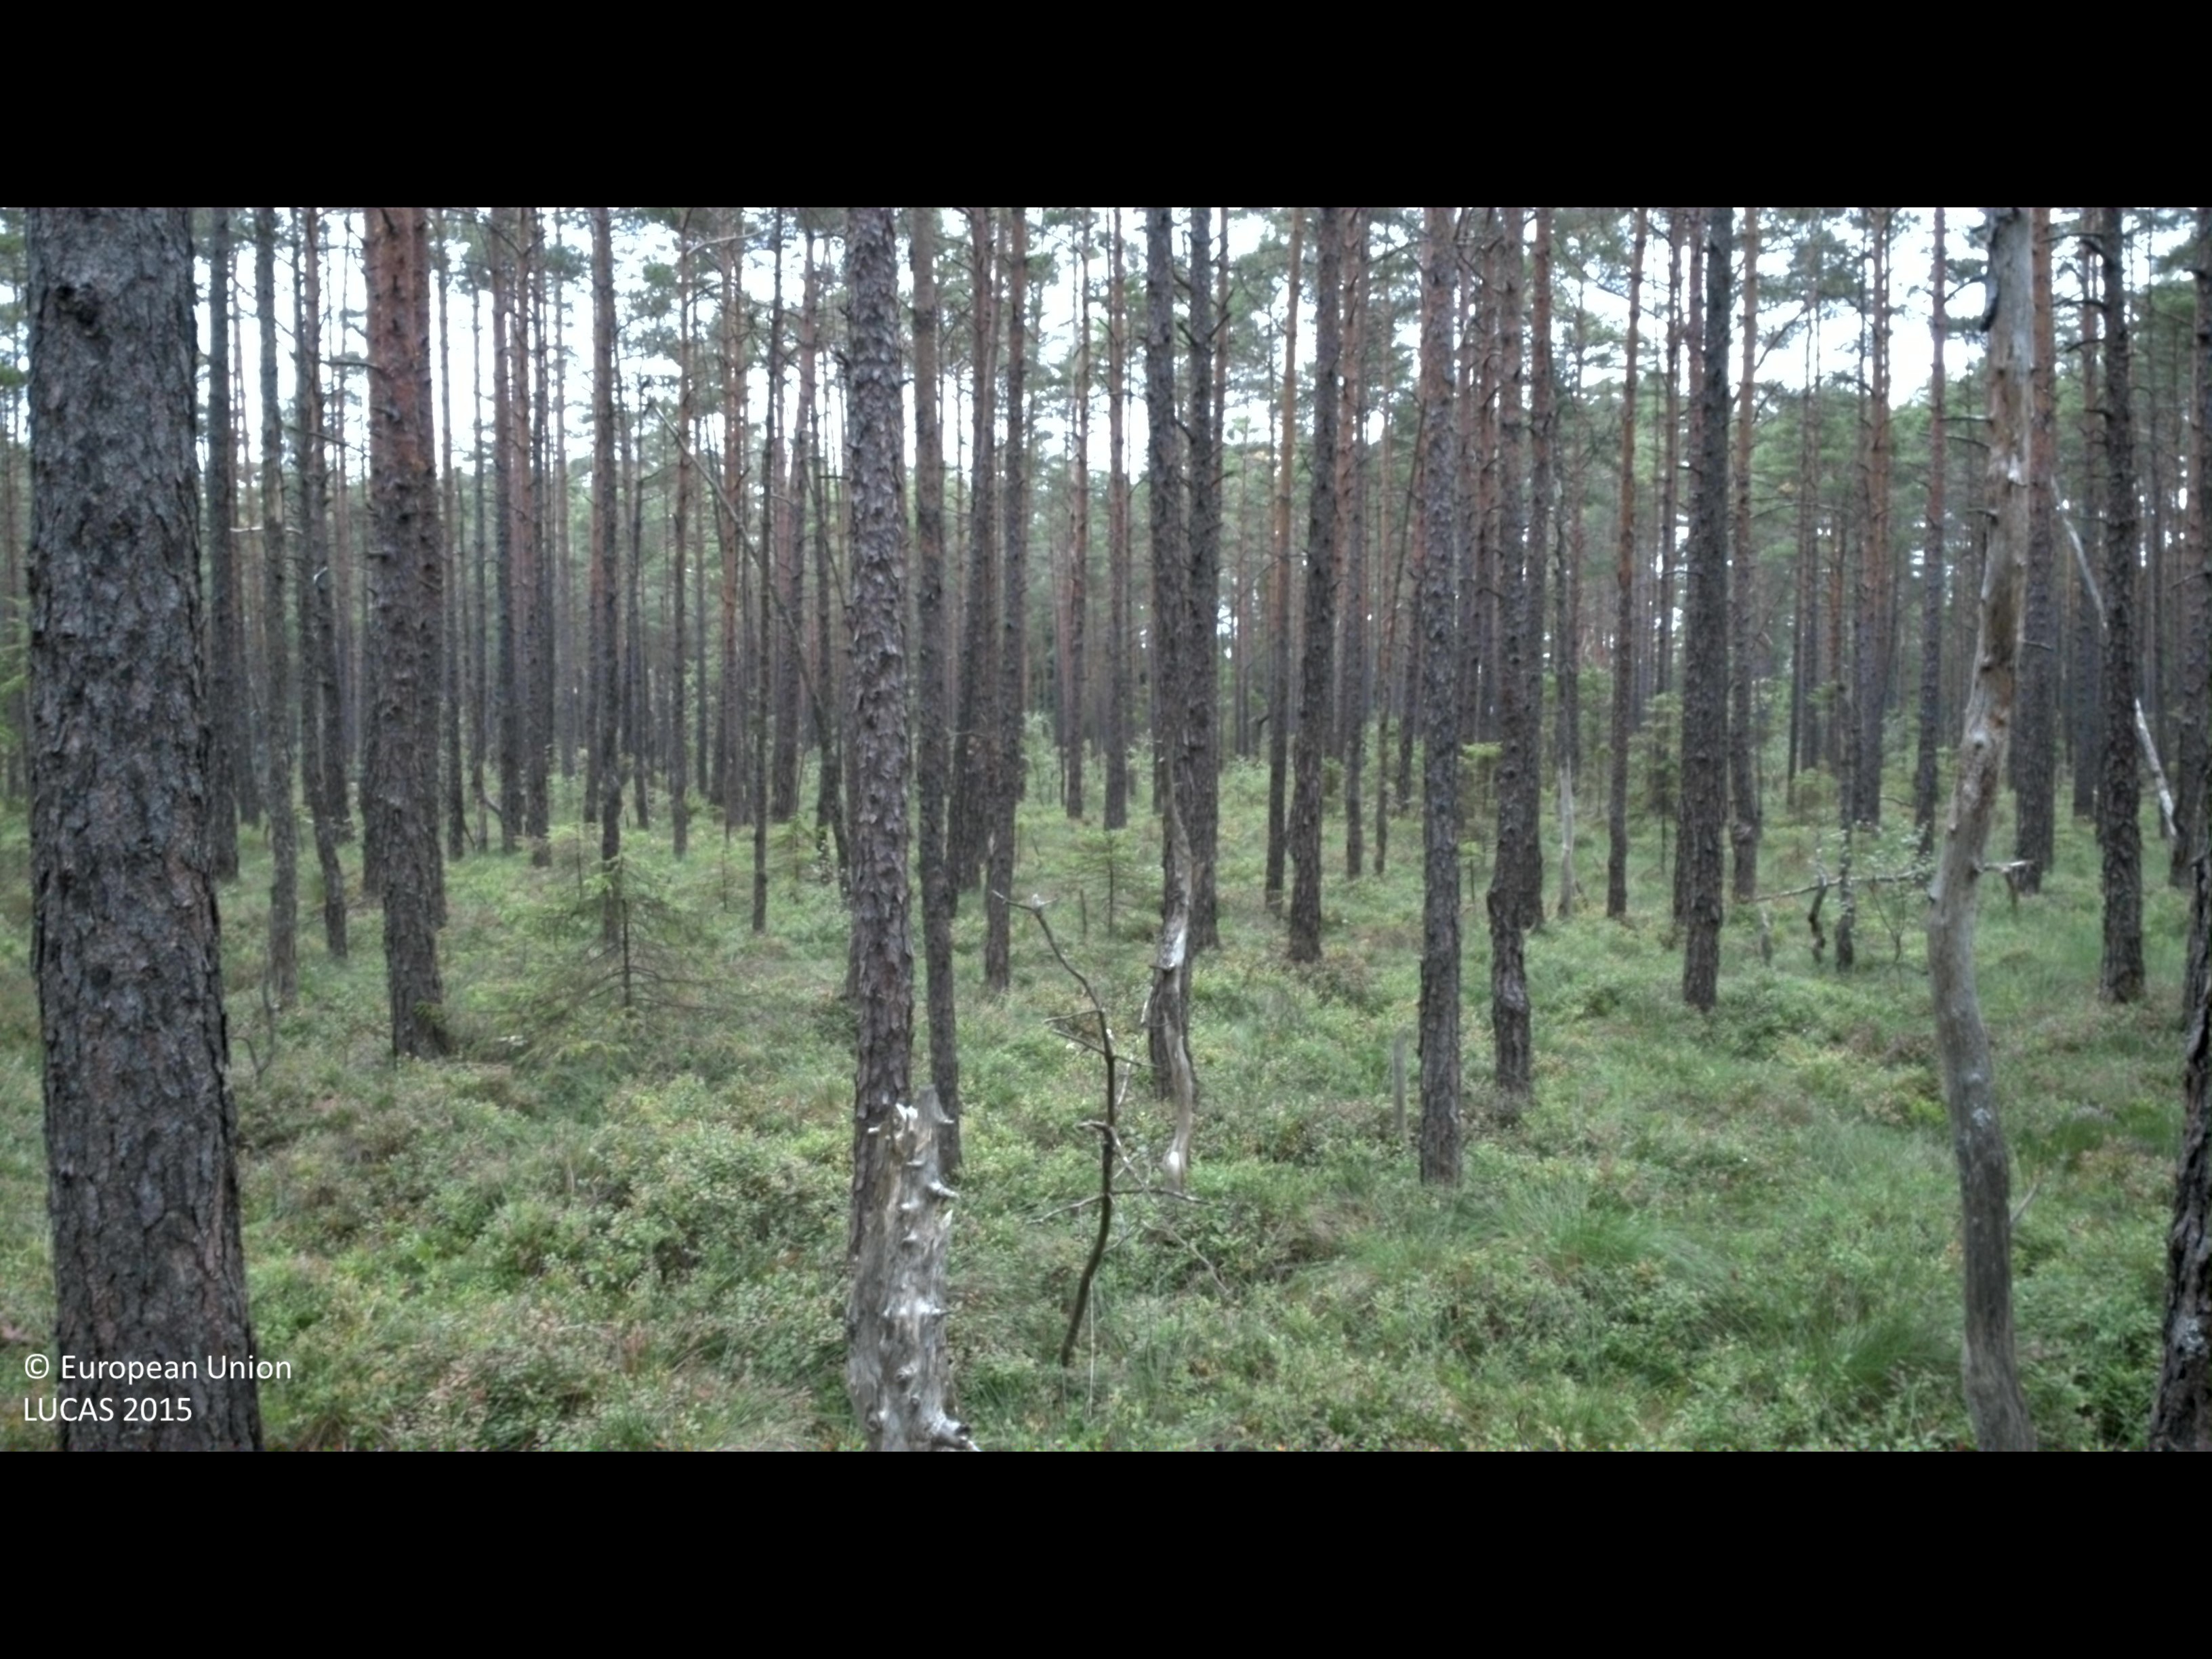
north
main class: Woodland
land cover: Pine dominated coniferous woodland
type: boreal forest
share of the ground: 50 - 75 %
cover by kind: coniferous forest trees 70 %, shrubs 30 %
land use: Forestry
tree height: > 5 m
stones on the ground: < 10 %
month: August
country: SE
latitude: 56.9044
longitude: 13.1657
